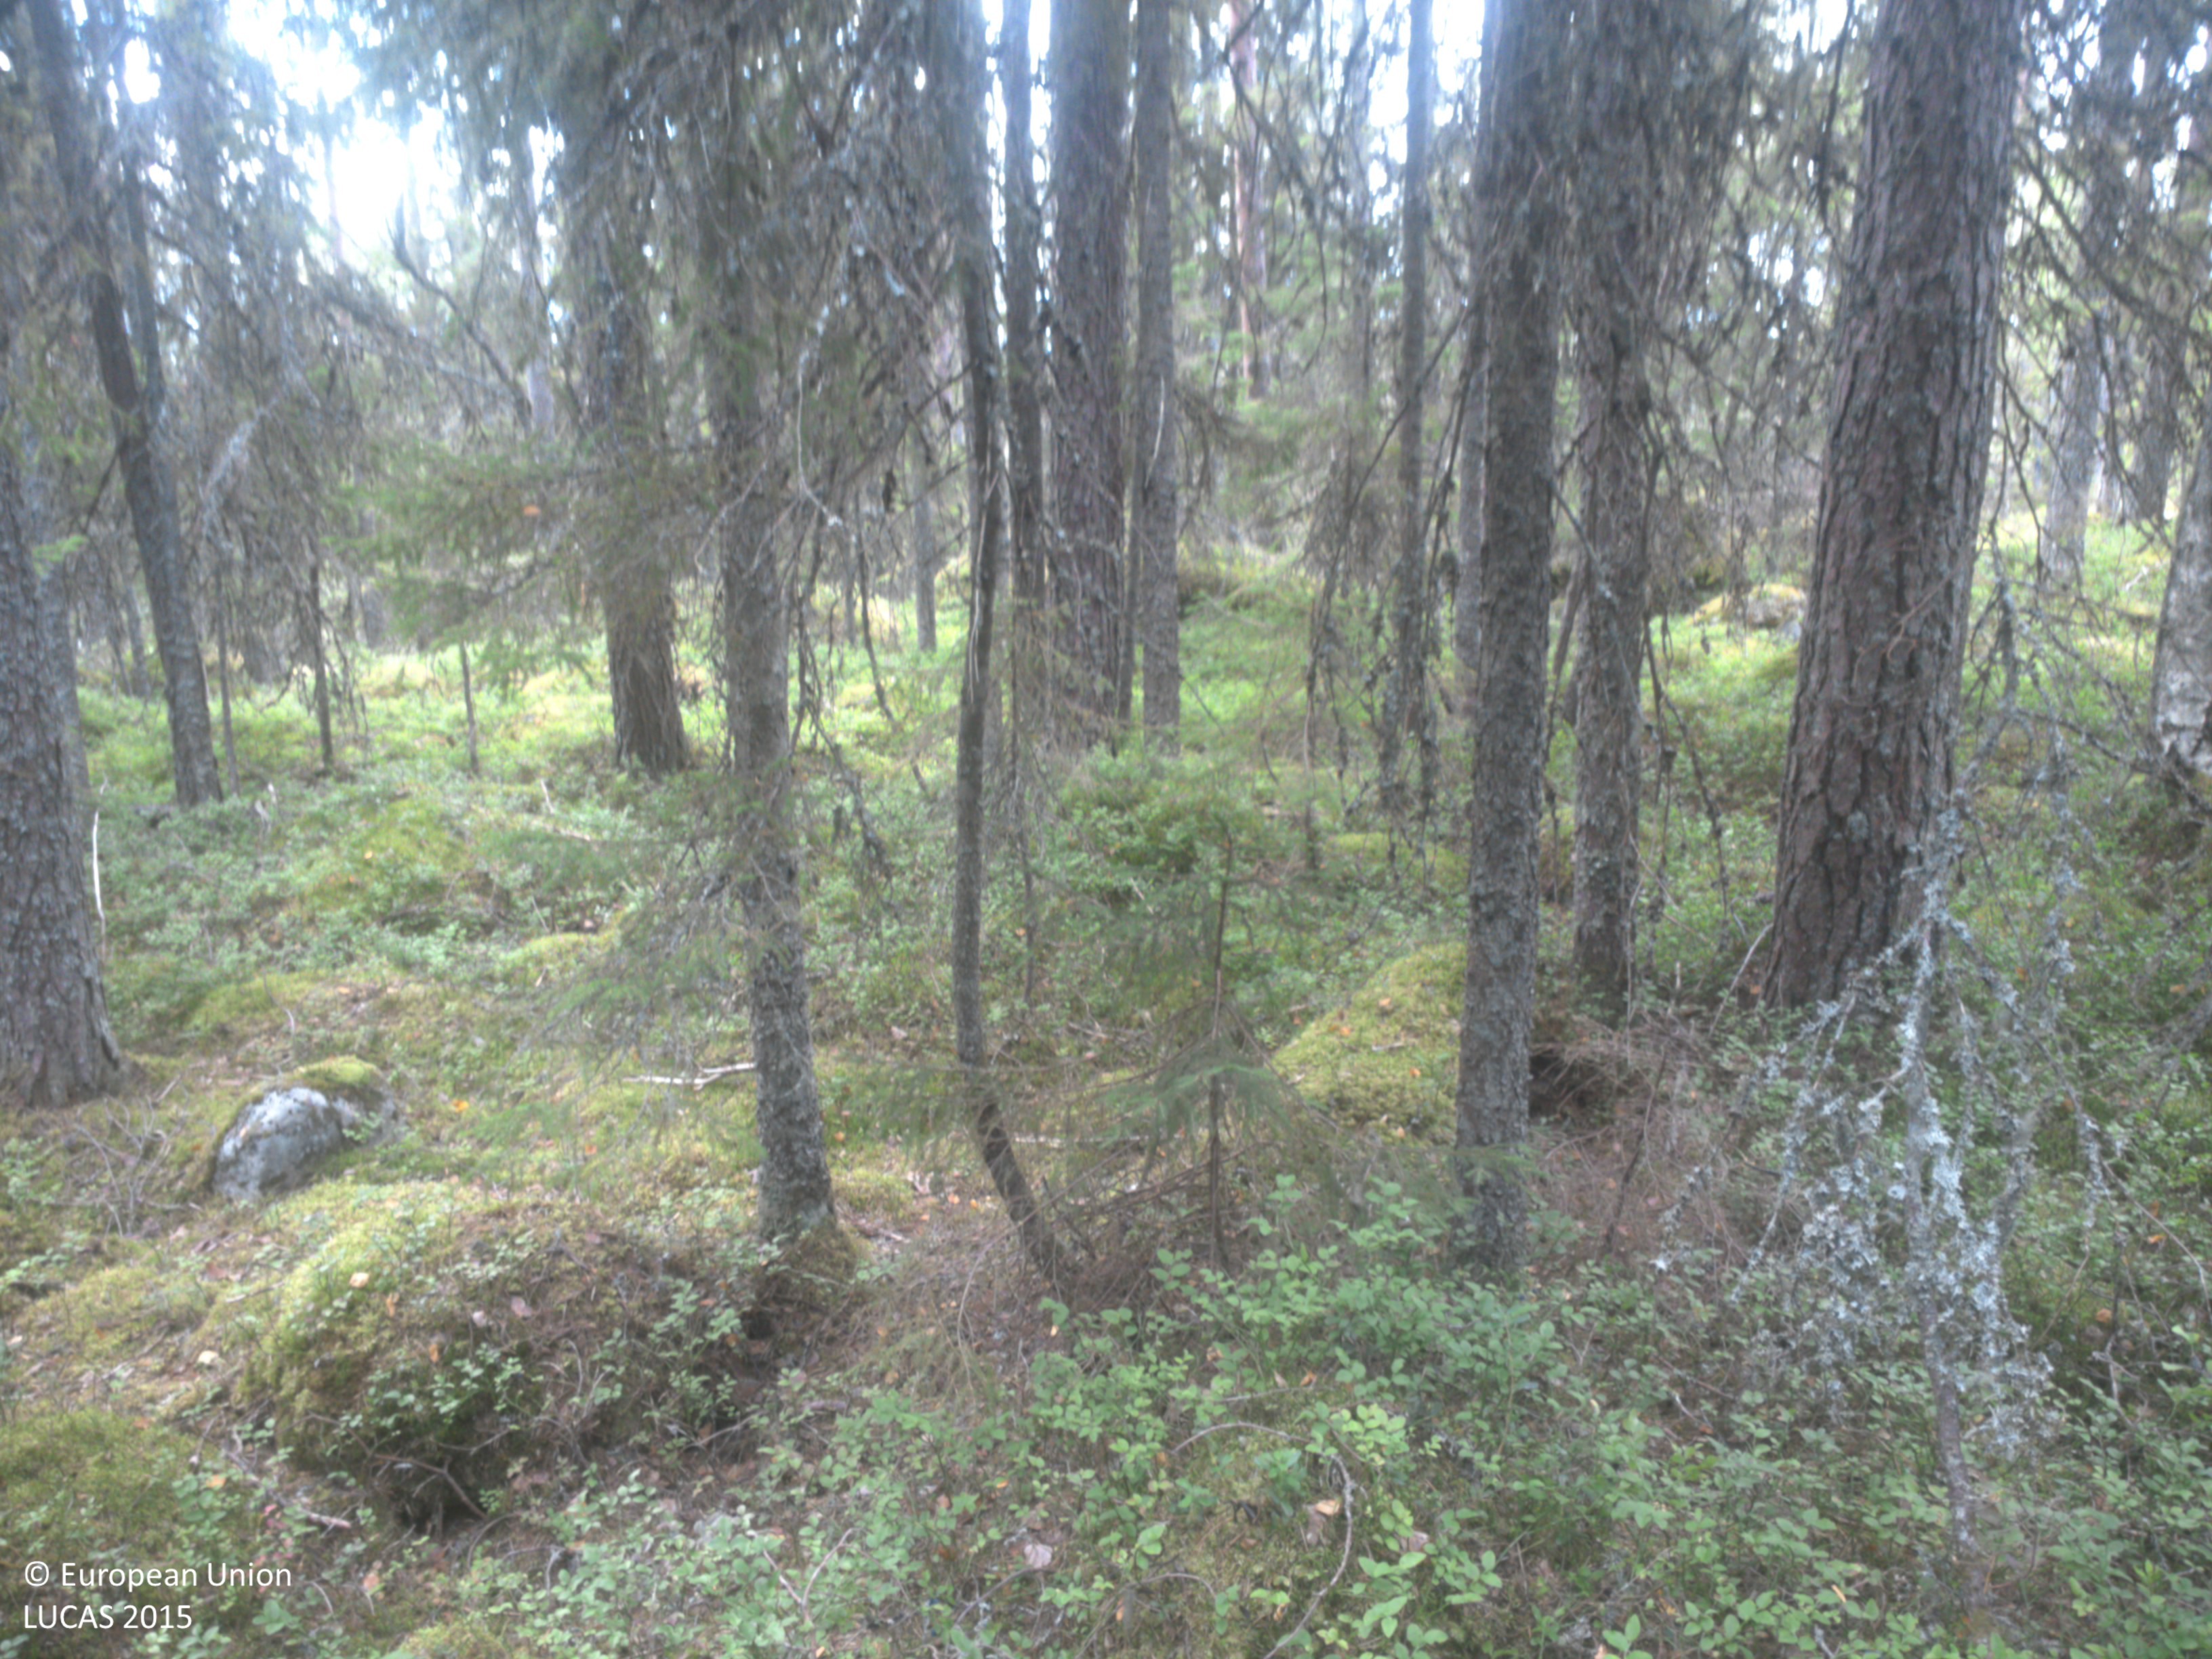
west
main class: Woodland
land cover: Other coniferous woodland
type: boreal forest
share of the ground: 50 - 75 %
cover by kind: coniferous forest trees 50 %, shrubs 50 %
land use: Forestry
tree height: > 5 m
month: August
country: SE
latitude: 63.6428
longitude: 19.4471
